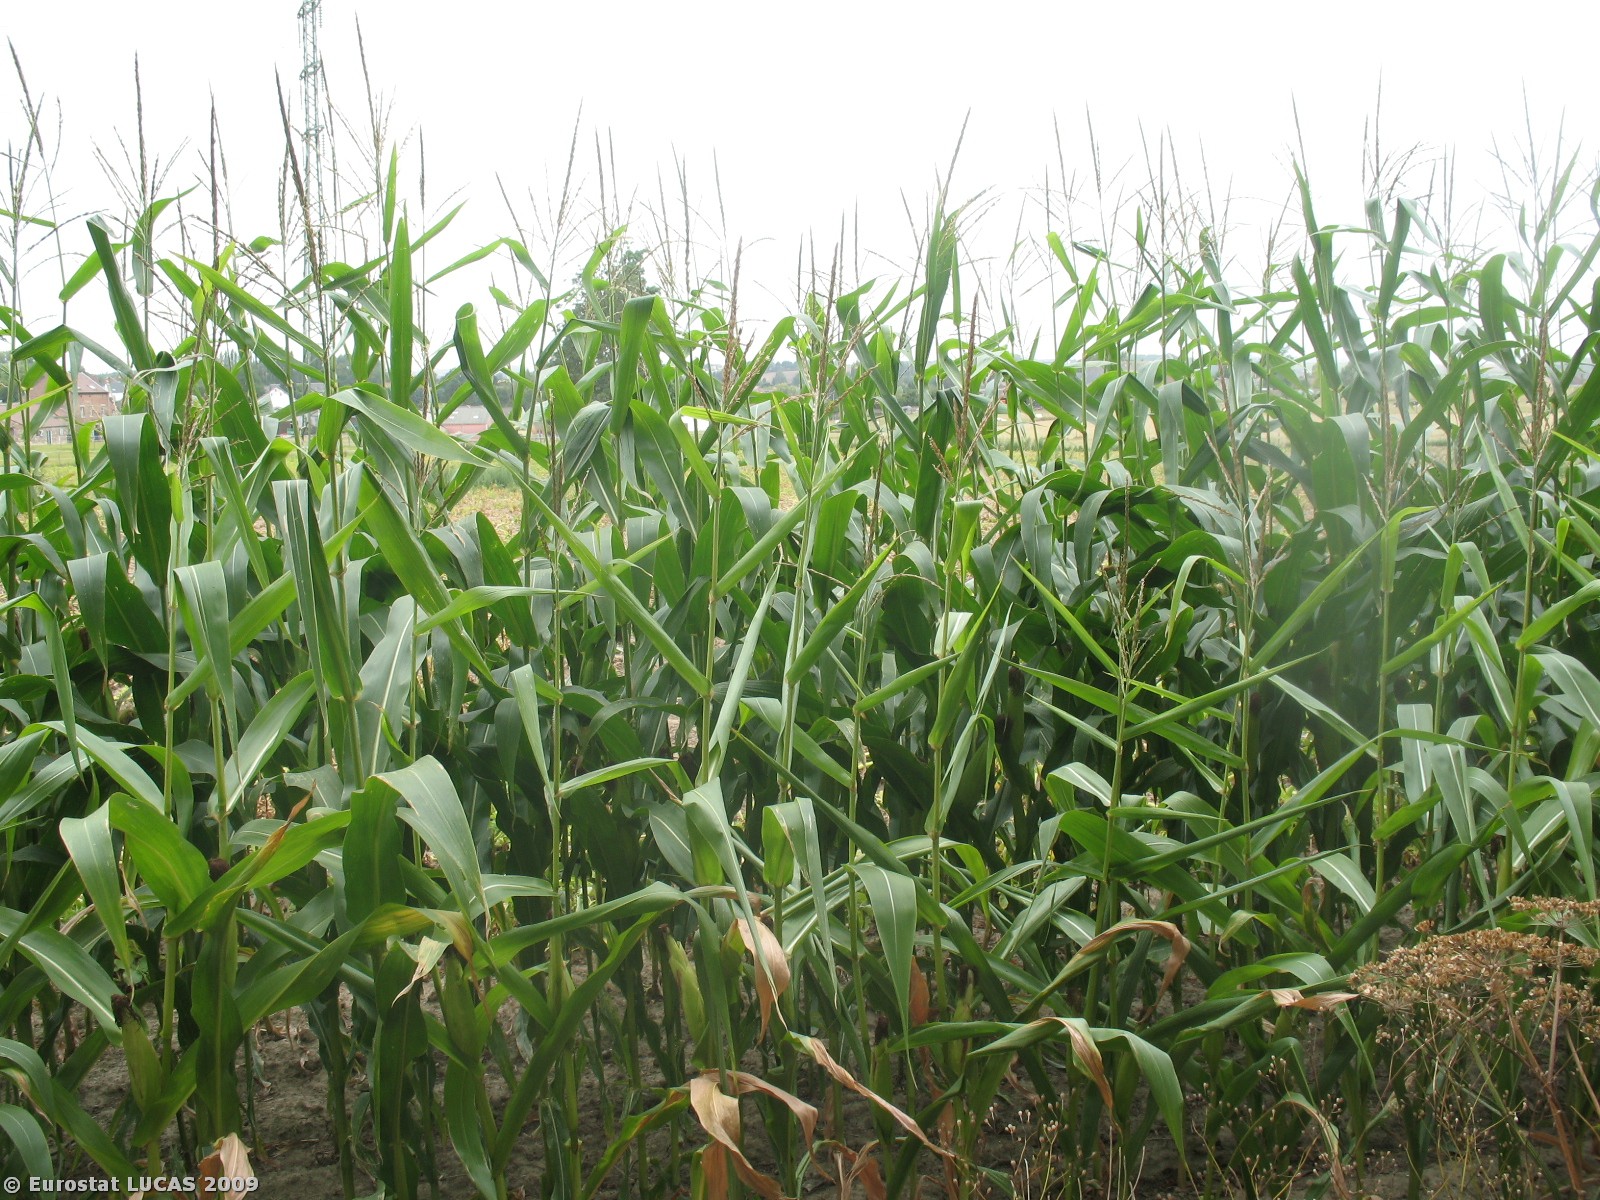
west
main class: Woodland
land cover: Broadleaved woodland
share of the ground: 50 - 75 %
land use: Unused
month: August
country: BE
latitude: 50.4945
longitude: 4.3426
